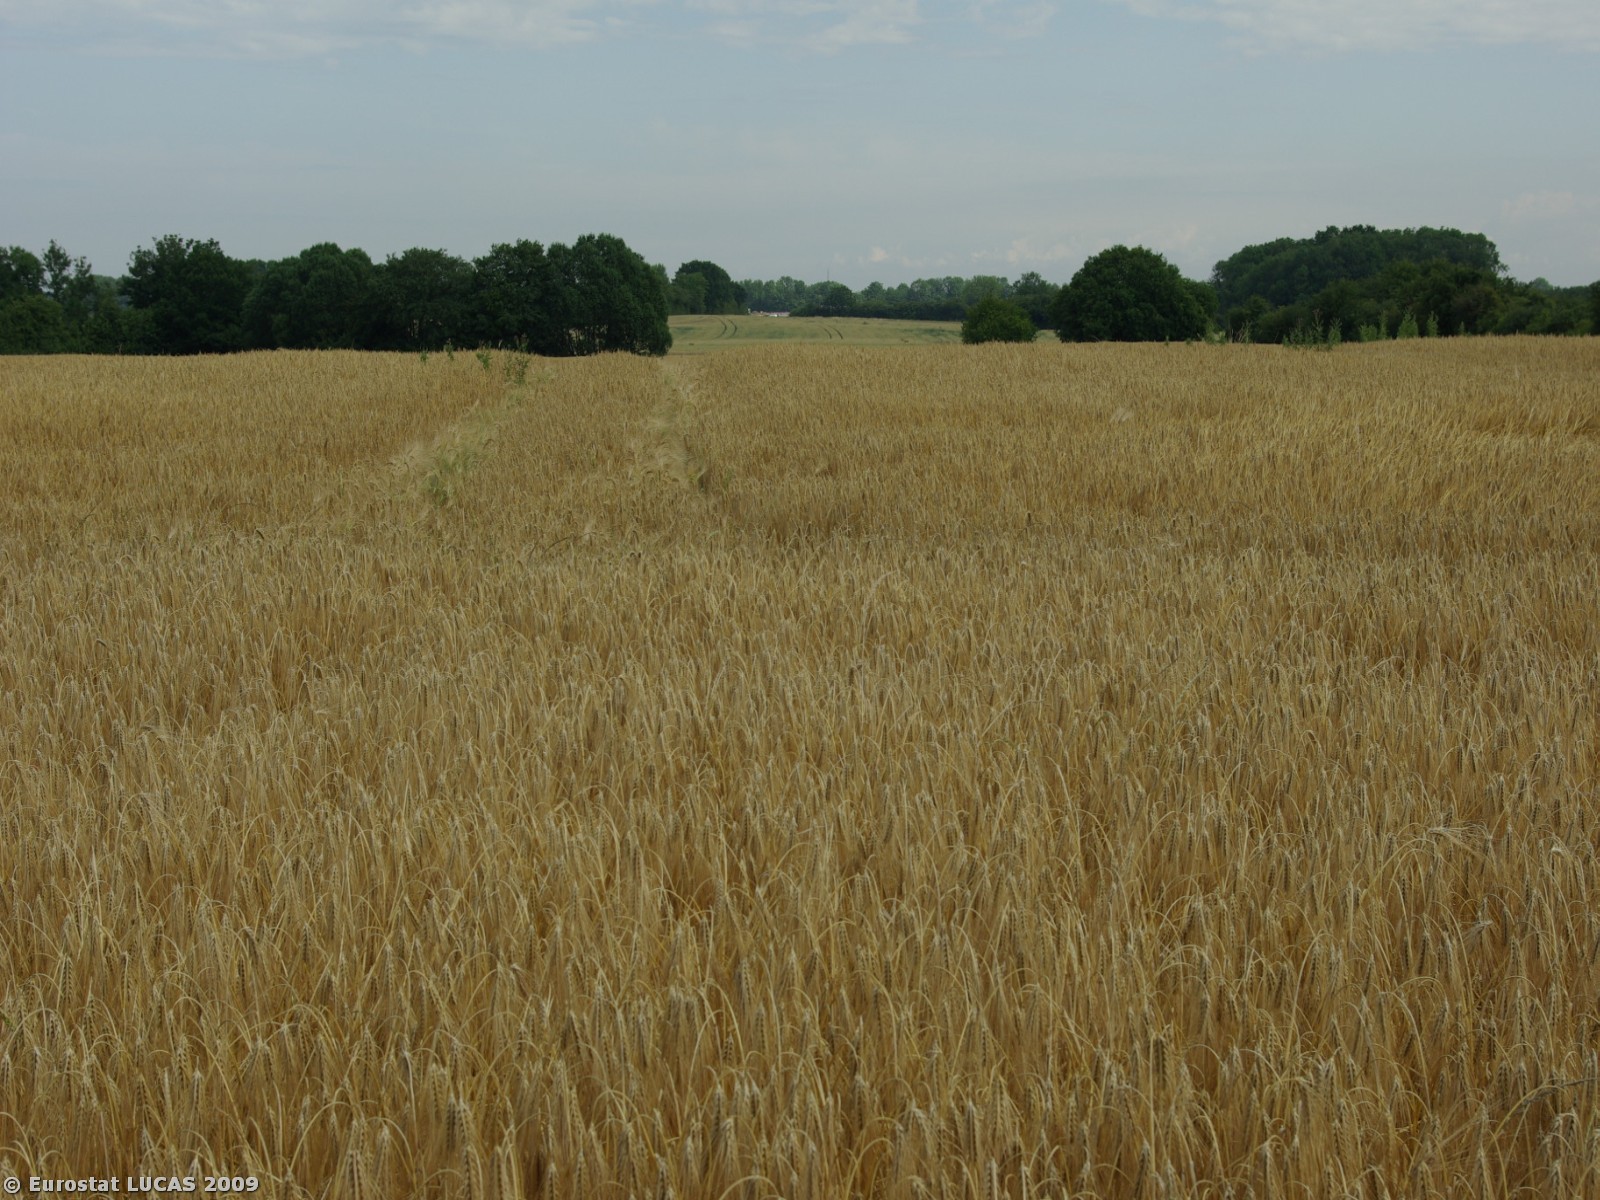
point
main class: Cropland
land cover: Barley
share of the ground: > 75 %
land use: Agriculture (excluding fallow land and kitchen gardens)
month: July
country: DK
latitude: 54.9115
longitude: 9.8597
